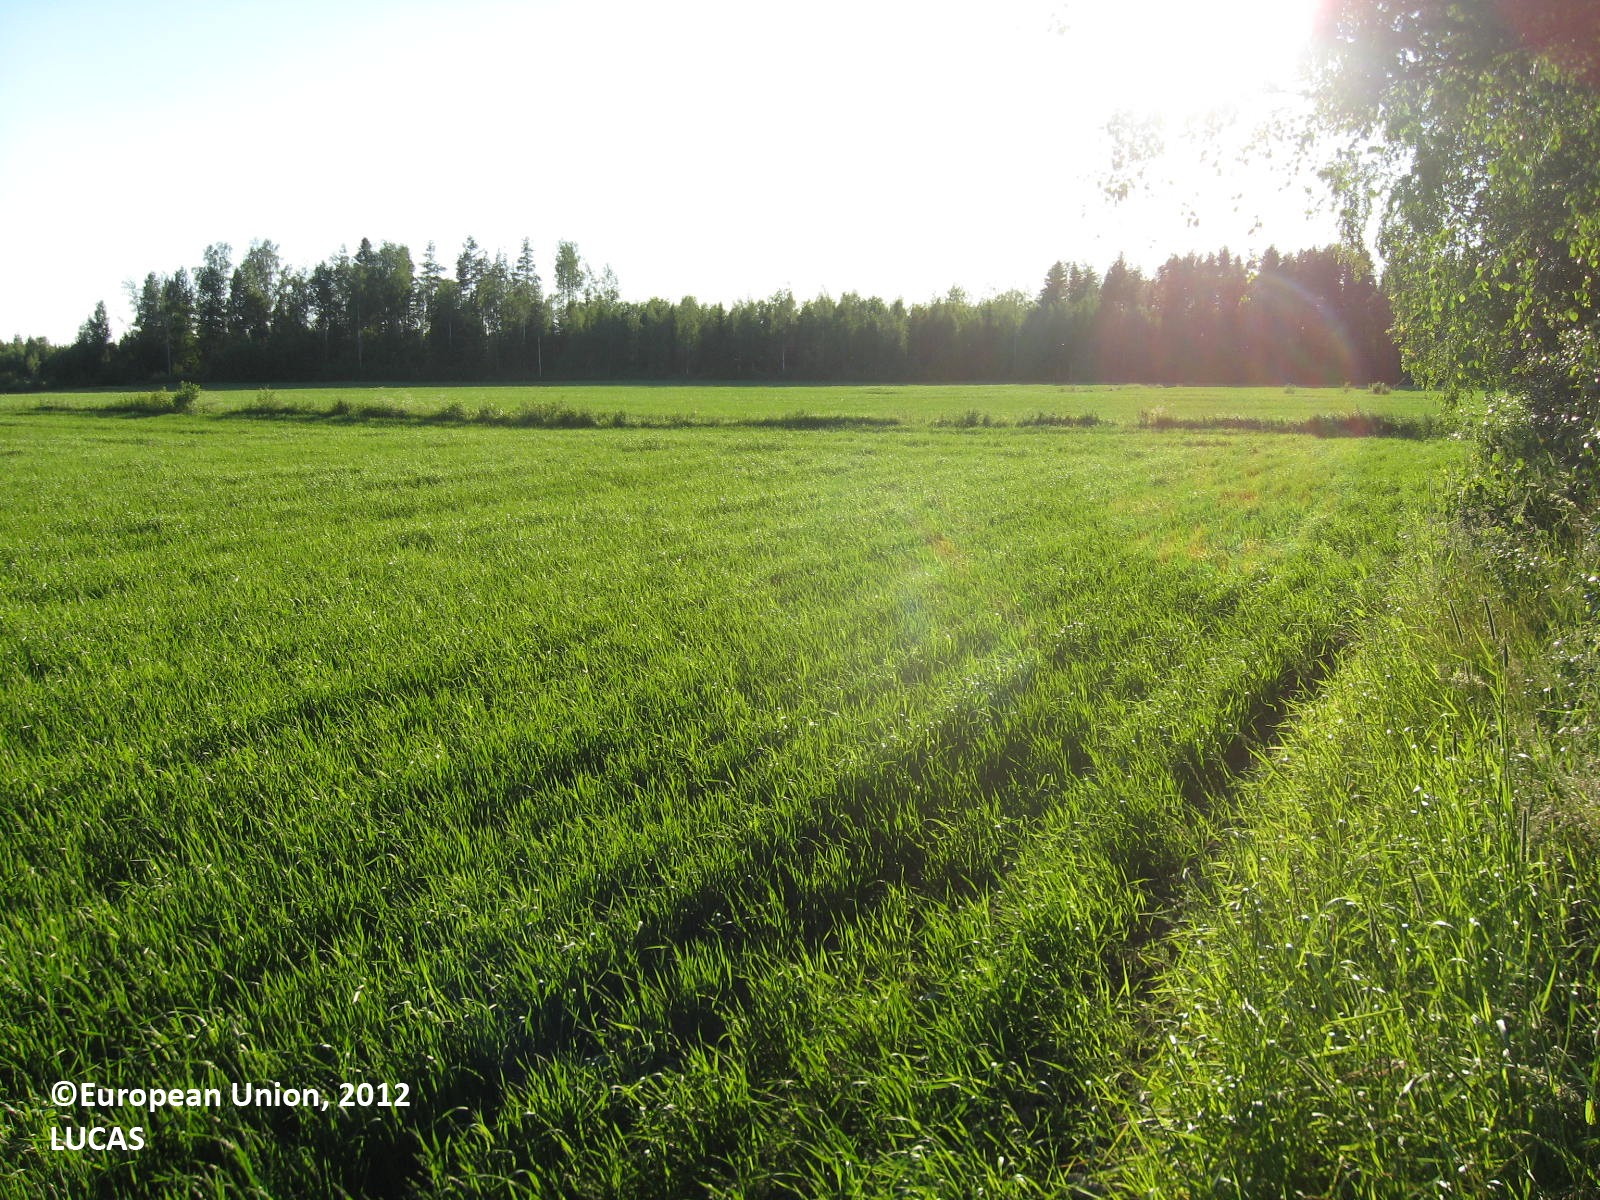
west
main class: Cropland
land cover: Oats
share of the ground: > 75 %
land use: Agriculture (excluding fallow land and kitchen gardens)
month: July
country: FI
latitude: 62.6736
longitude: 22.7300
